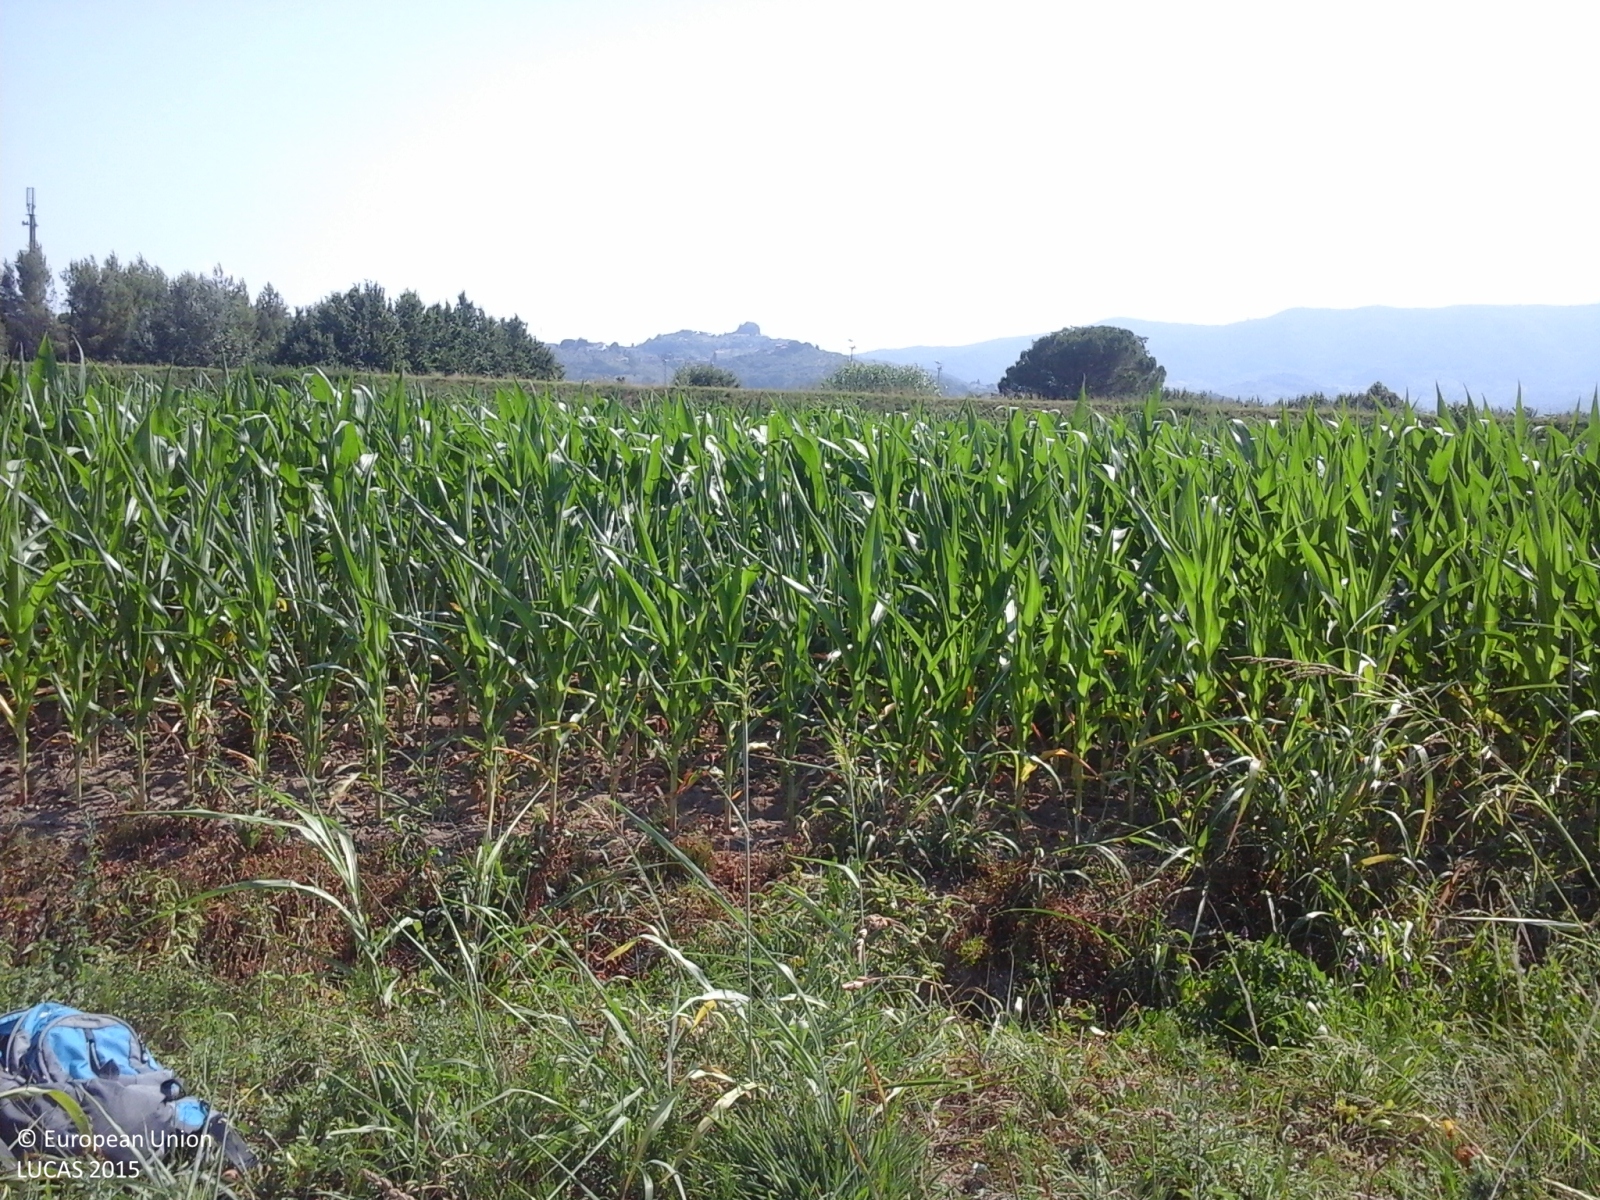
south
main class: Grassland
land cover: Spontaneously vegetated surfaces
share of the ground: > 75 %
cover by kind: herbaceous plants 100 %
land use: Fallow land
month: July
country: IT
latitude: 43.8403
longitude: 11.0297
